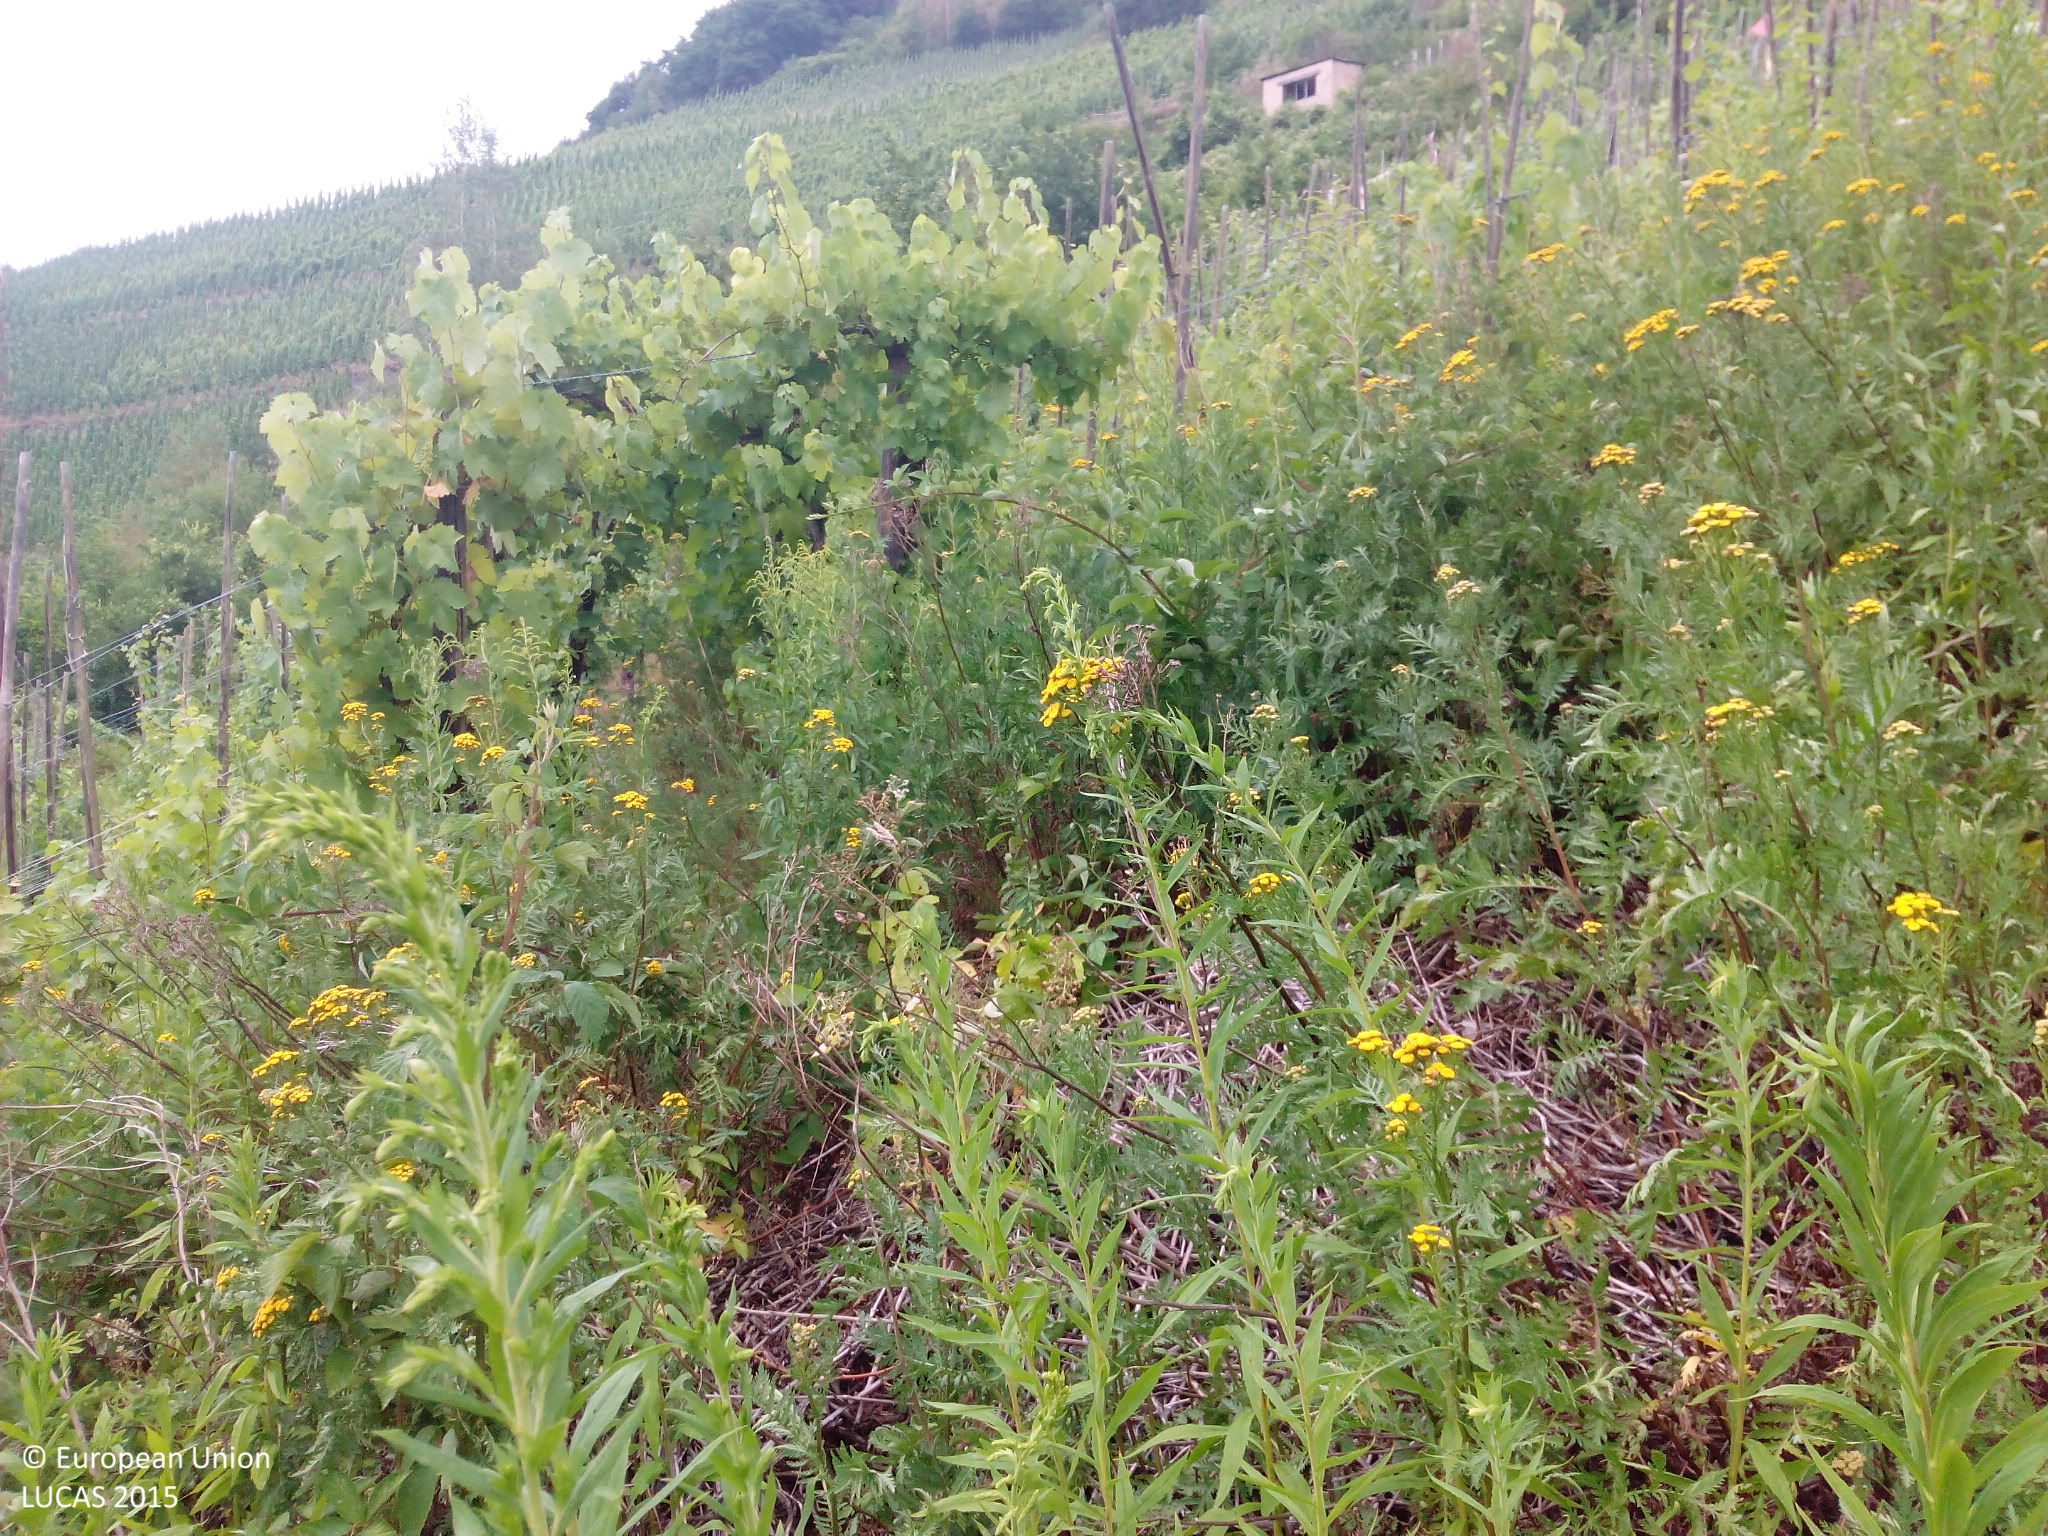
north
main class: Shrubland
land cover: Shrubland with sparse tree cover
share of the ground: > 75 %
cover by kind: shrubs 70 %, herbaceous plants 25 %, broadleaved forest trees 5 %
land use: Abandoned areas
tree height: < 5 m
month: July
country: DE
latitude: 49.9319
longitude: 7.1164
